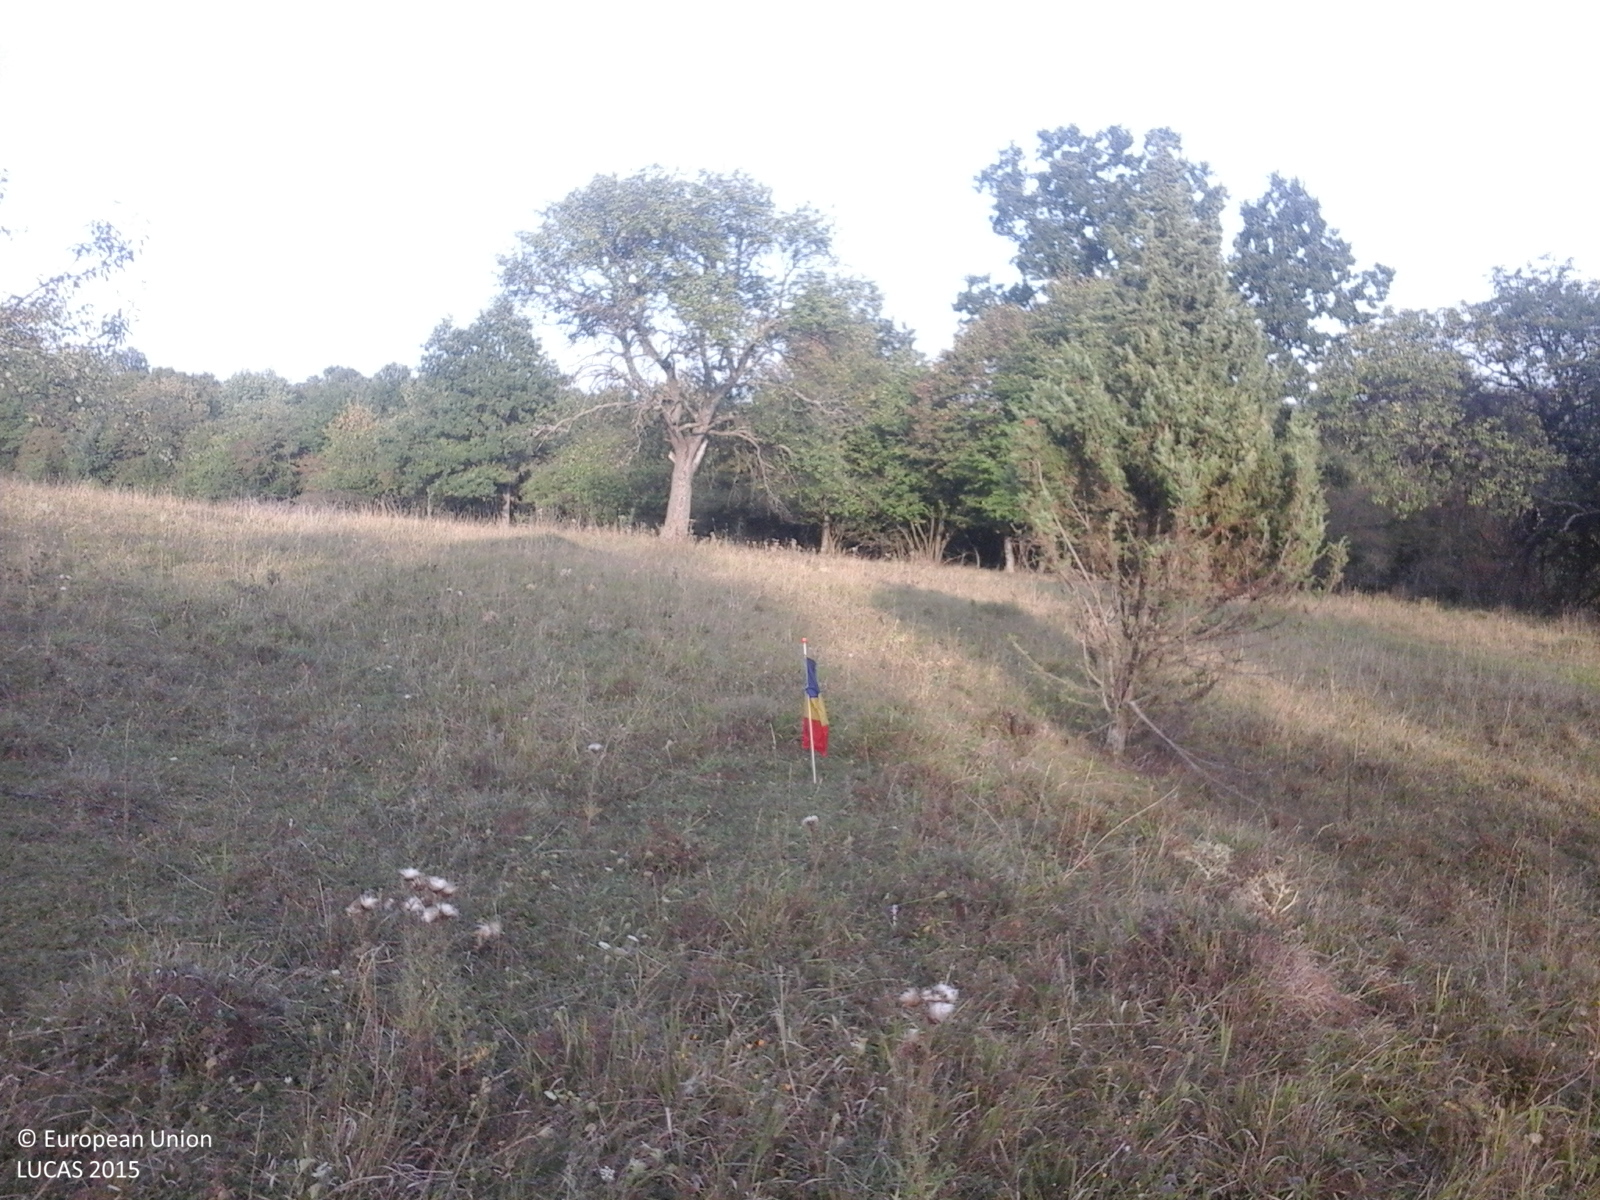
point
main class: Grassland
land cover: Grassland with sparse tree/shrub cover
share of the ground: > 75 %
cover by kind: herbaceous plants 85 %, shrubs 10 %, broadleaved forest trees 5 %
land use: Fallow land
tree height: < 5 m
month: September
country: RO
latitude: 46.8206
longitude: 23.0781
